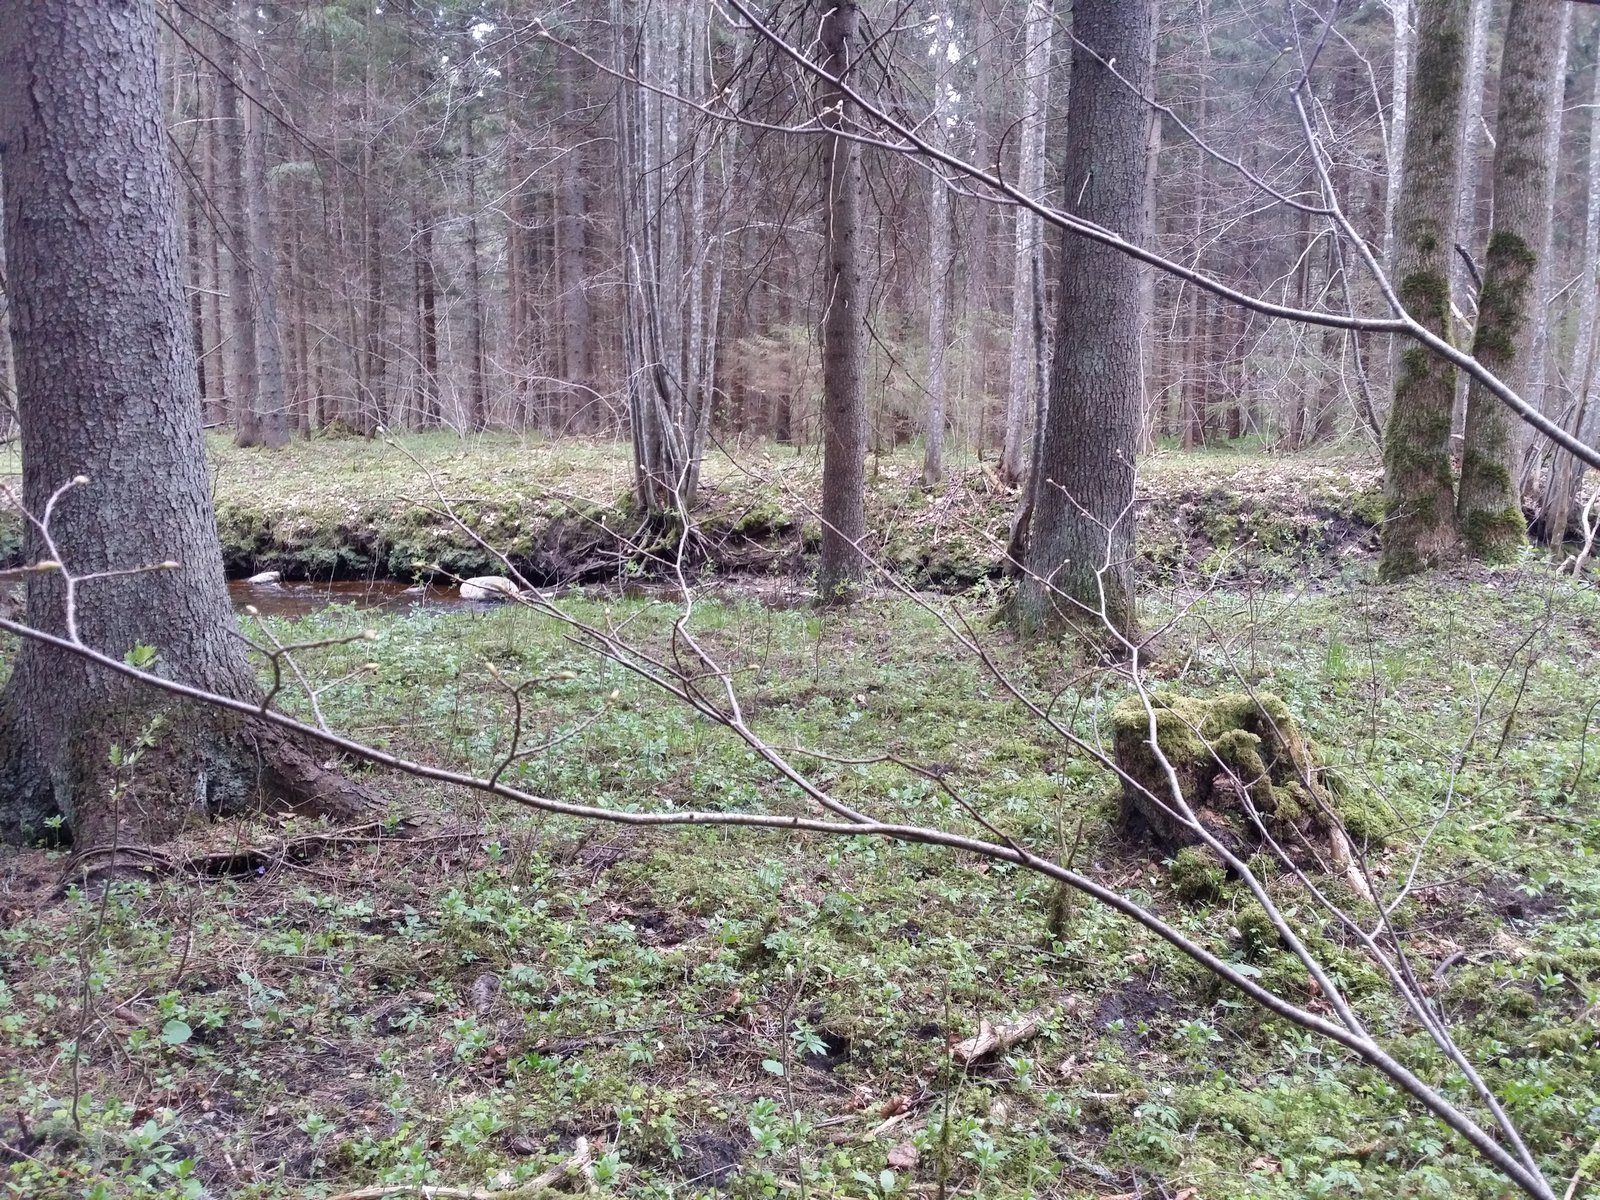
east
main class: Woodland
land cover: Spruce dominated mixed woodland
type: hemiboreal forest and nemoral coniferous forest and mixed broadleaved-coniferous forest
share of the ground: > 75 %
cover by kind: coniferous forest trees 65 %, broadleaved forest trees 25 %, lichens and mosses 10 %
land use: Forestry
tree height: > 5 m
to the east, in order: Spruce dominated mixed woodland; Inland fresh running water; Spruce dominated mixed woodland; Inland fresh running water; Spruce dominated coniferous woodland; Spruce dominated mixed woodland
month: May
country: LV
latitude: 57.3785
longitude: 26.0129
